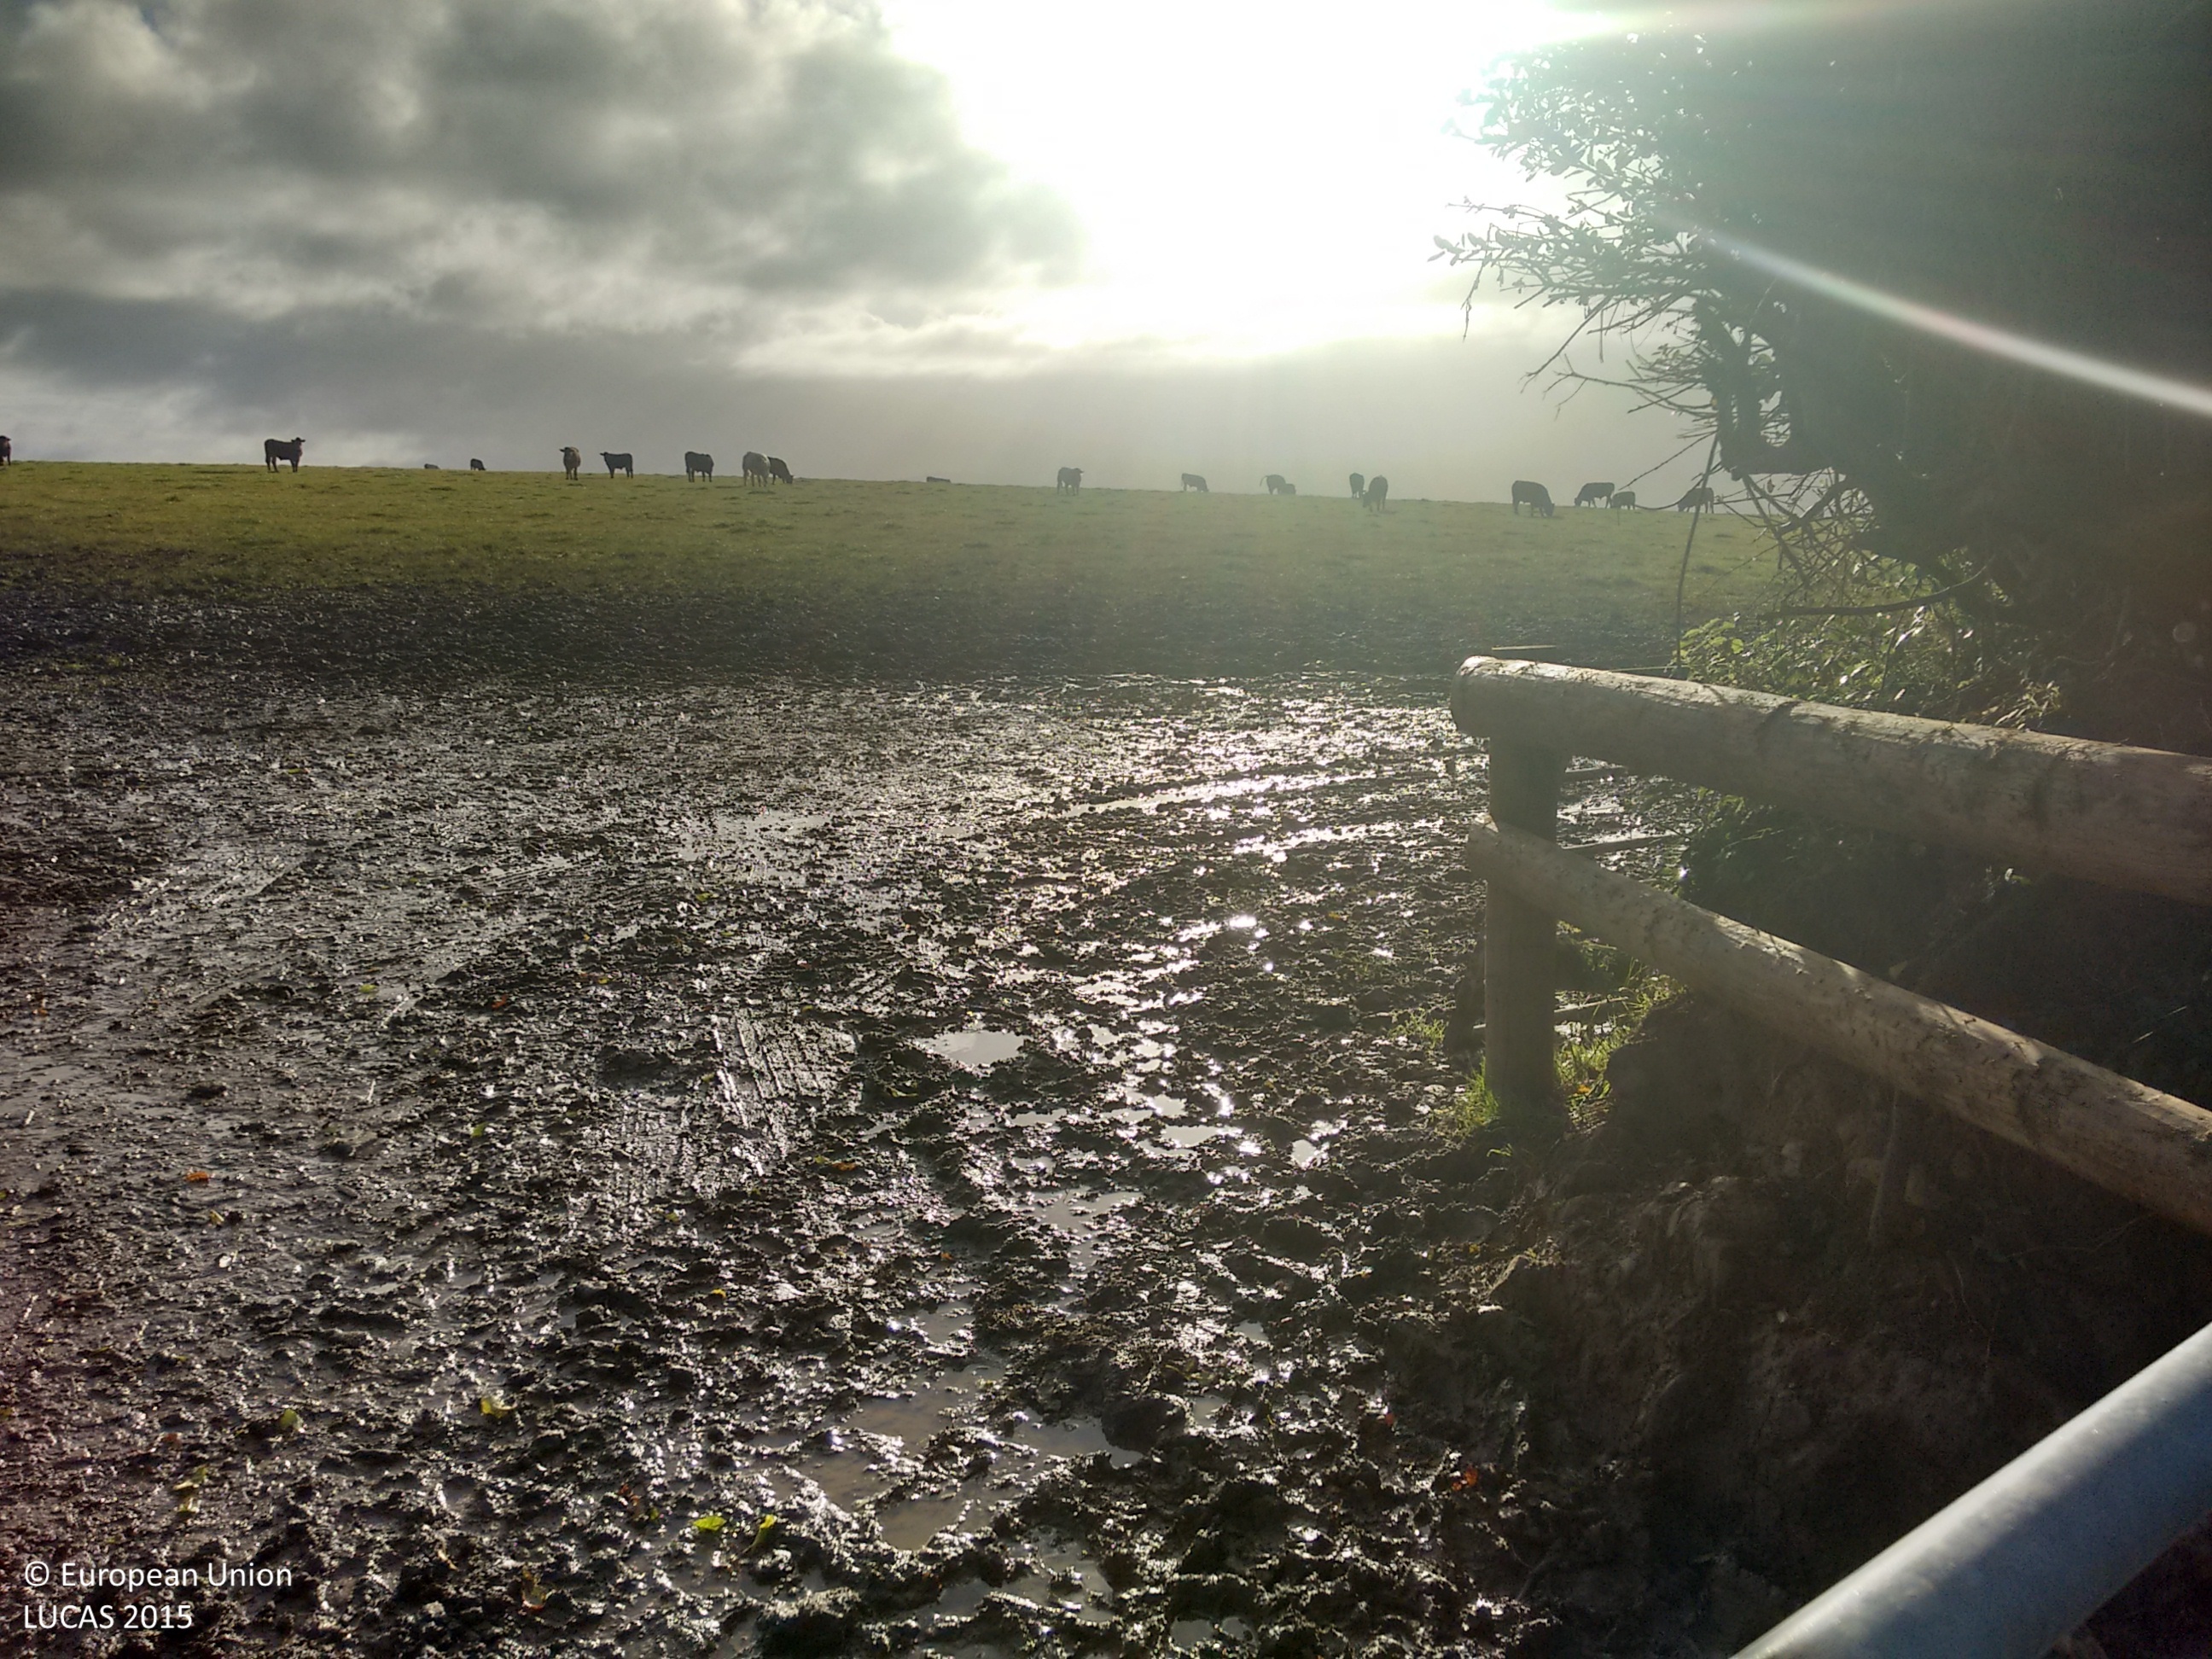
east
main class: Grassland
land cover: Grassland without tree/shrub cover
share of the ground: > 75 %
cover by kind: herbaceous plants 100 %
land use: Agriculture (excluding fallow land and kitchen gardens)
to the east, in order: Grassland without tree/shrub cover; Broadleaved woodland
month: September
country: GB
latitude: 50.7013
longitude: -4.1569
